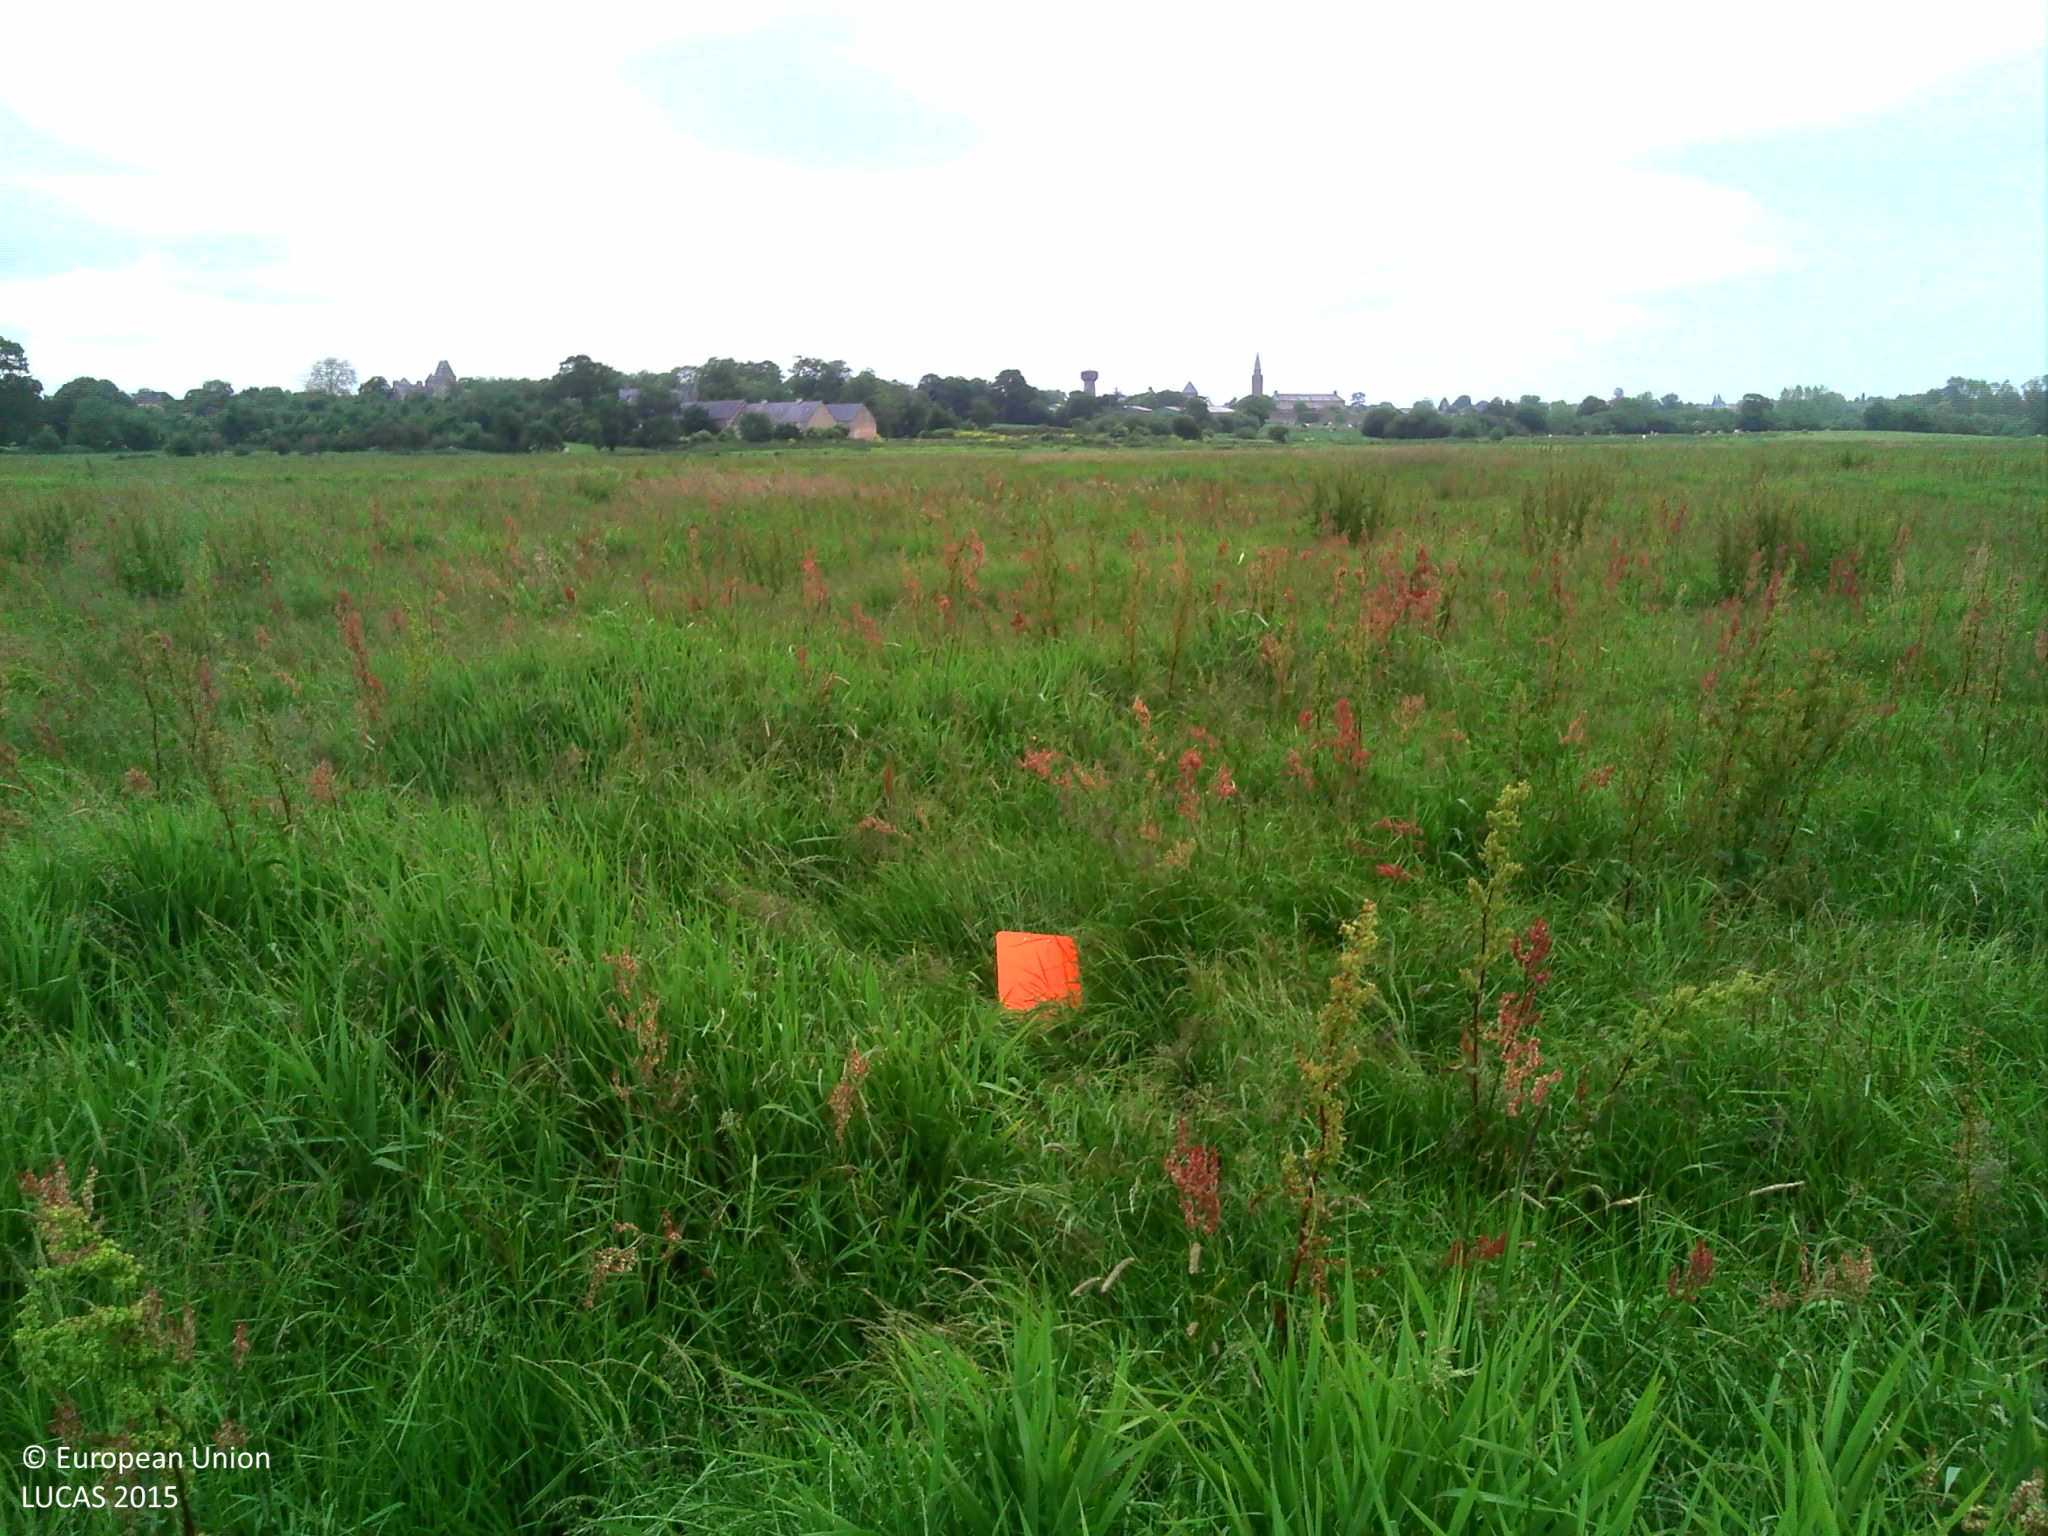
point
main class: Grassland
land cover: Grassland without tree/shrub cover
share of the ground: > 75 %
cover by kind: herbaceous plants 100 %
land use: Agriculture (excluding fallow land and kitchen gardens)
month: June
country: FR
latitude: 49.3704
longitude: -1.4374
